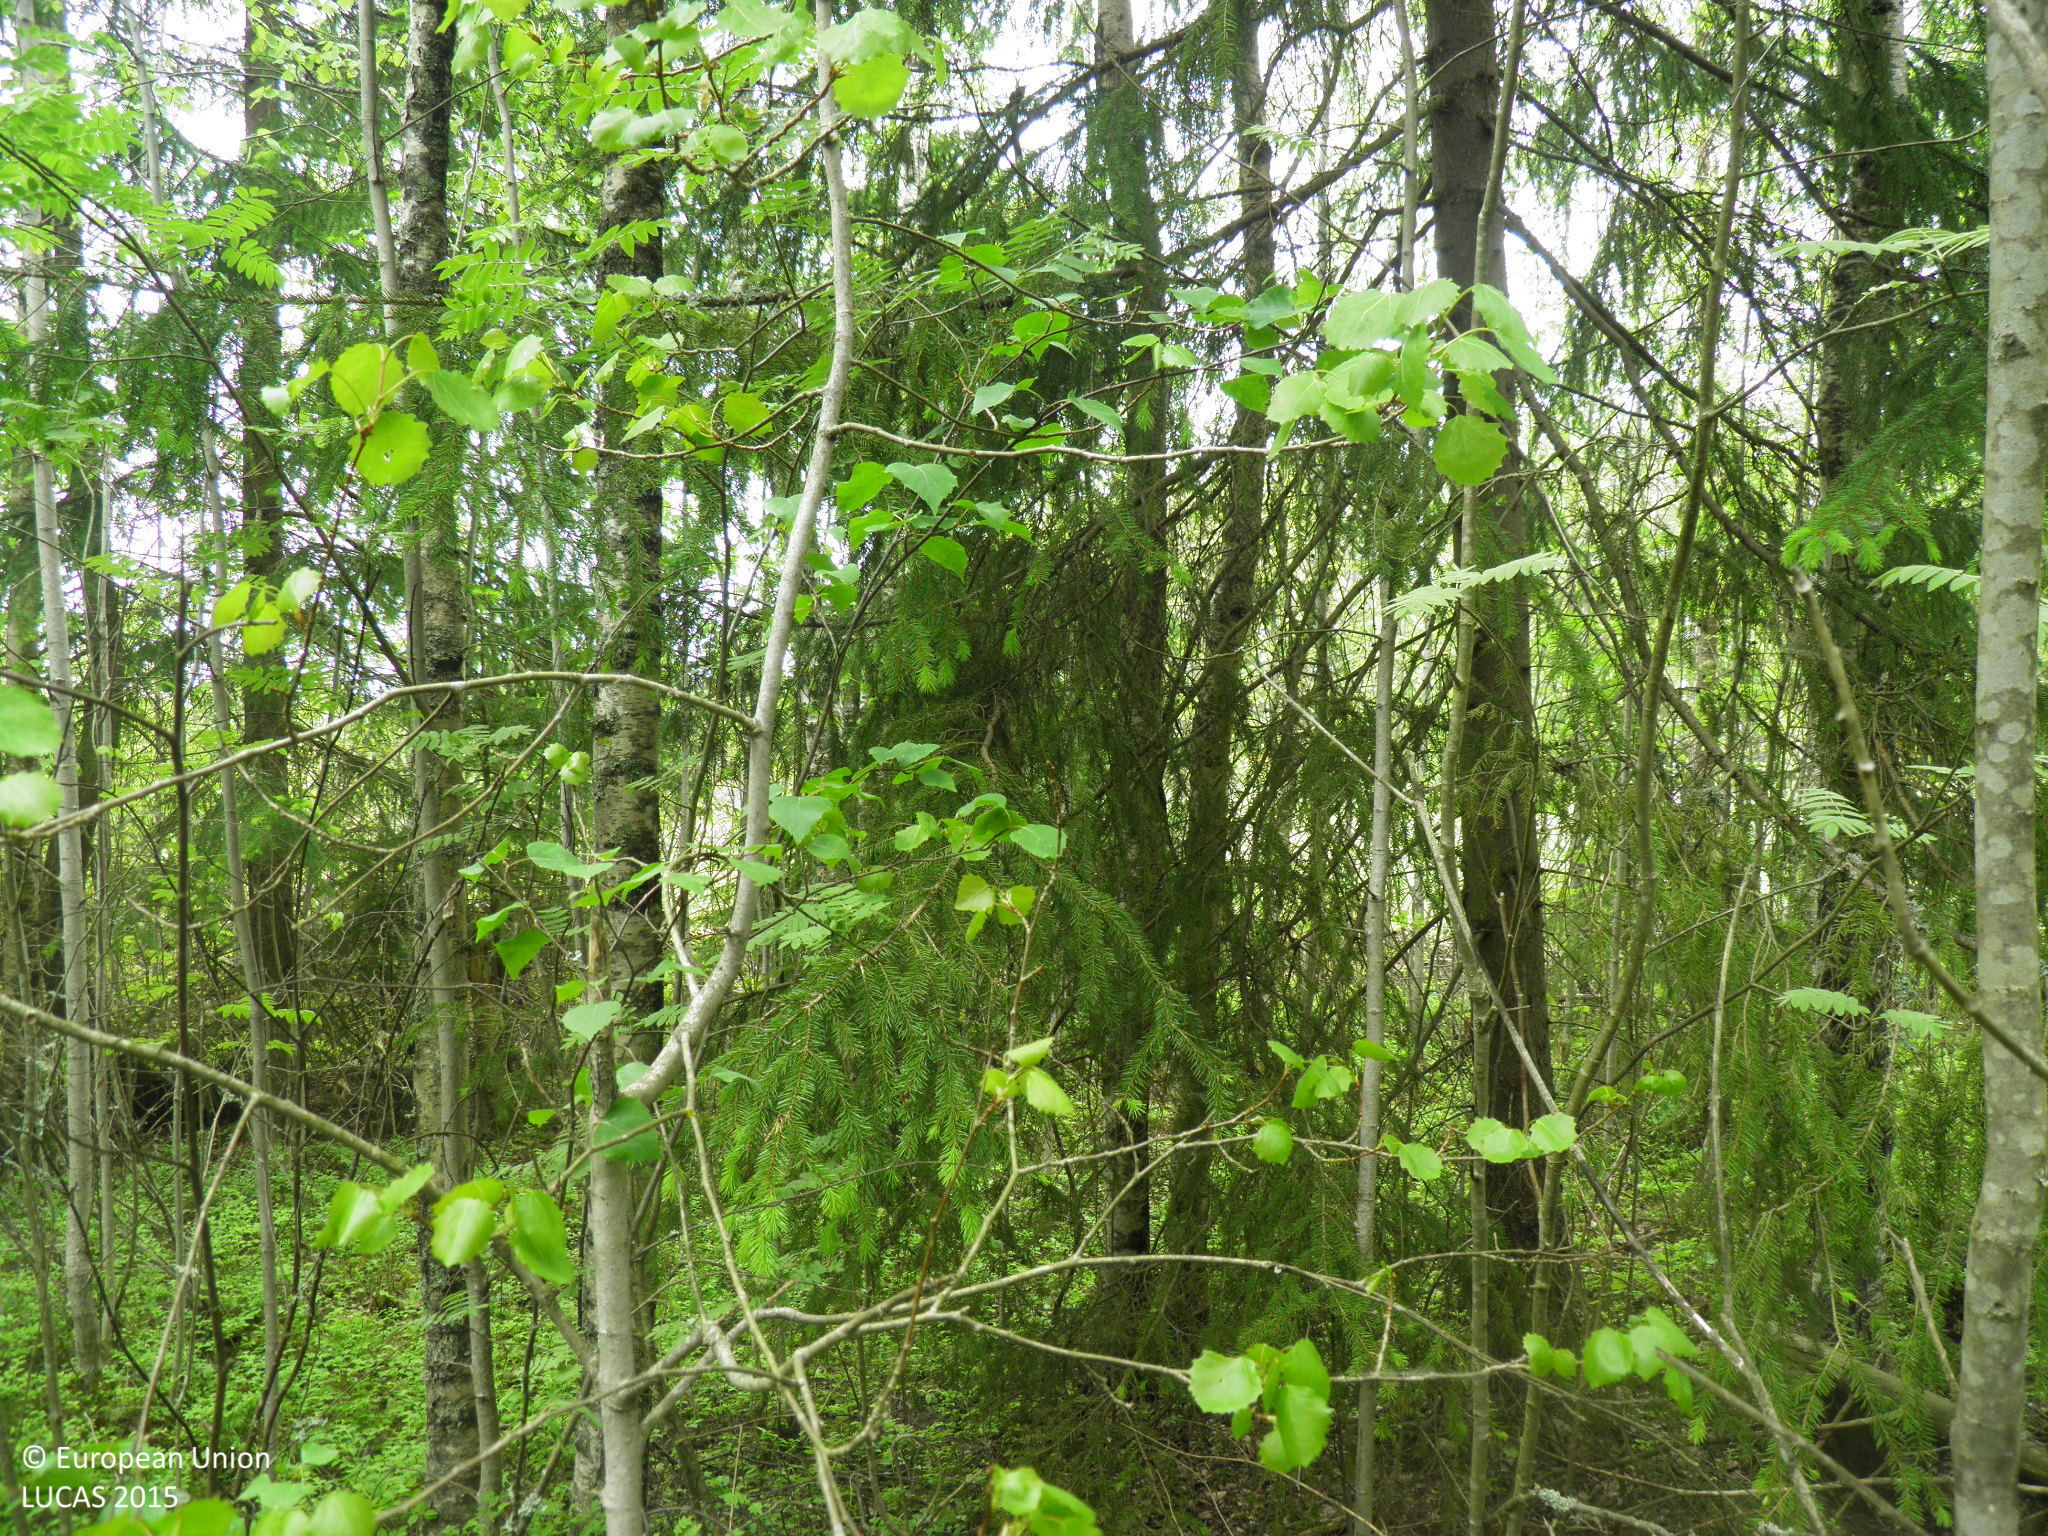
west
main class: Woodland
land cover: Other mixed woodland
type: boreal forest
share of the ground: > 75 %
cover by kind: coniferous forest trees 55 %, broadleaved forest trees 35 %, shrubs 5 %, herbaceous plants 5 %
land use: Forestry
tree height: > 5 m
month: June
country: FI
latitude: 60.4384
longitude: 21.9282
